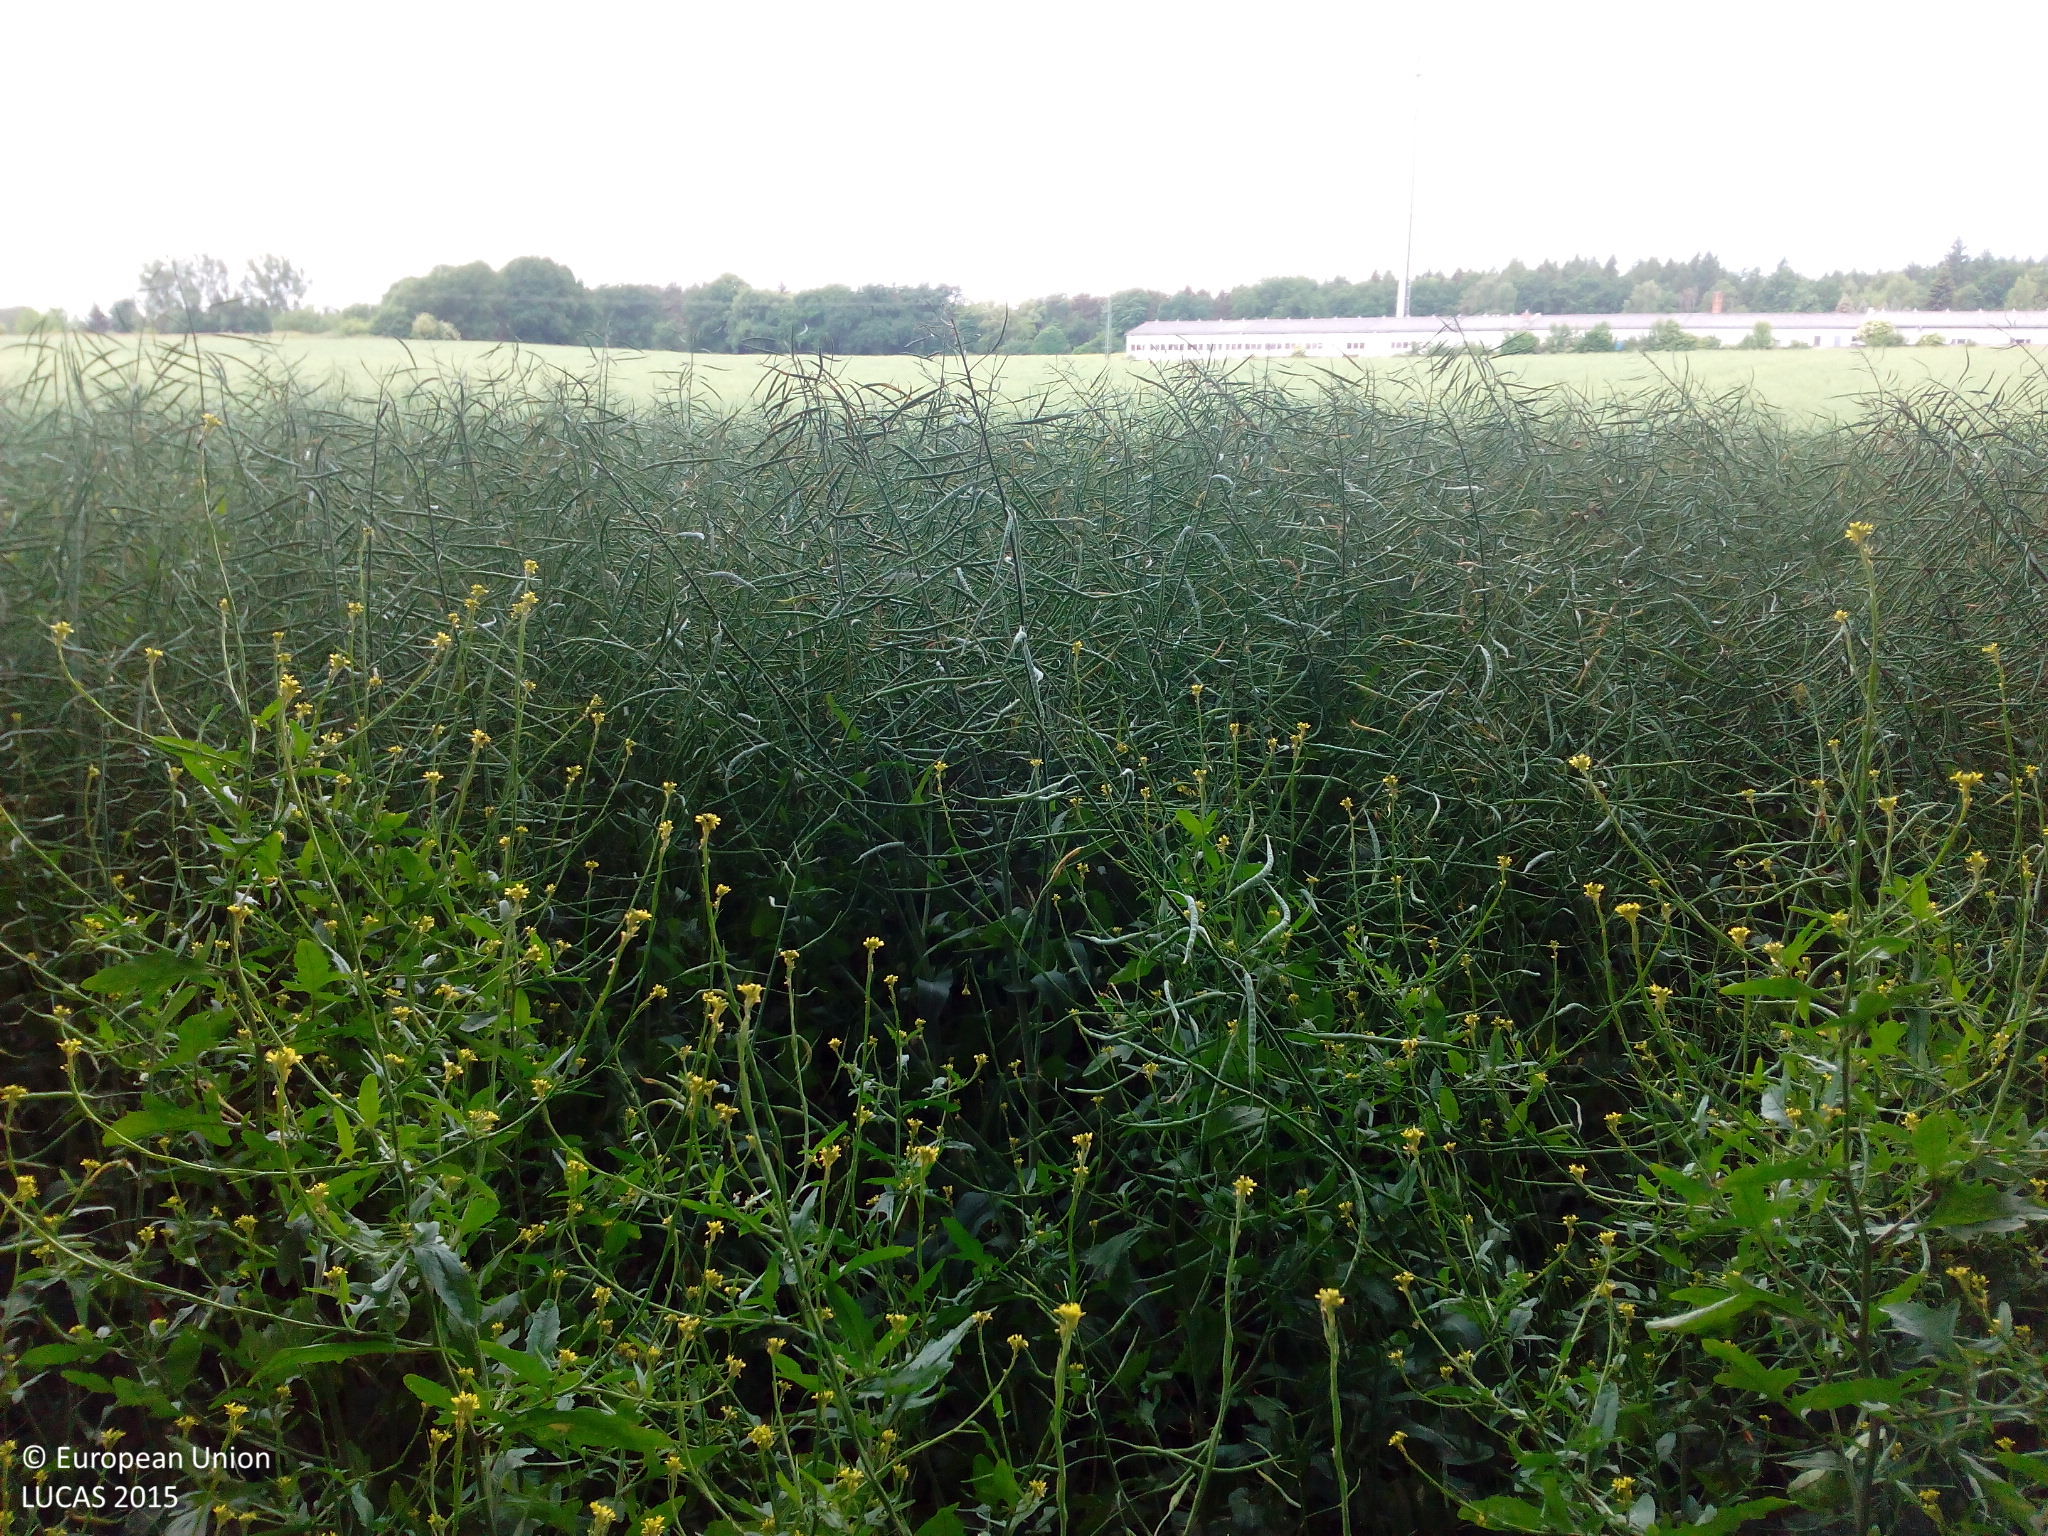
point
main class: Cropland
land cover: Rape and turnip rape
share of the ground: > 75 %
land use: Agriculture (excluding fallow land and kitchen gardens)
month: June
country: DE
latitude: 53.6300
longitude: 11.1638
